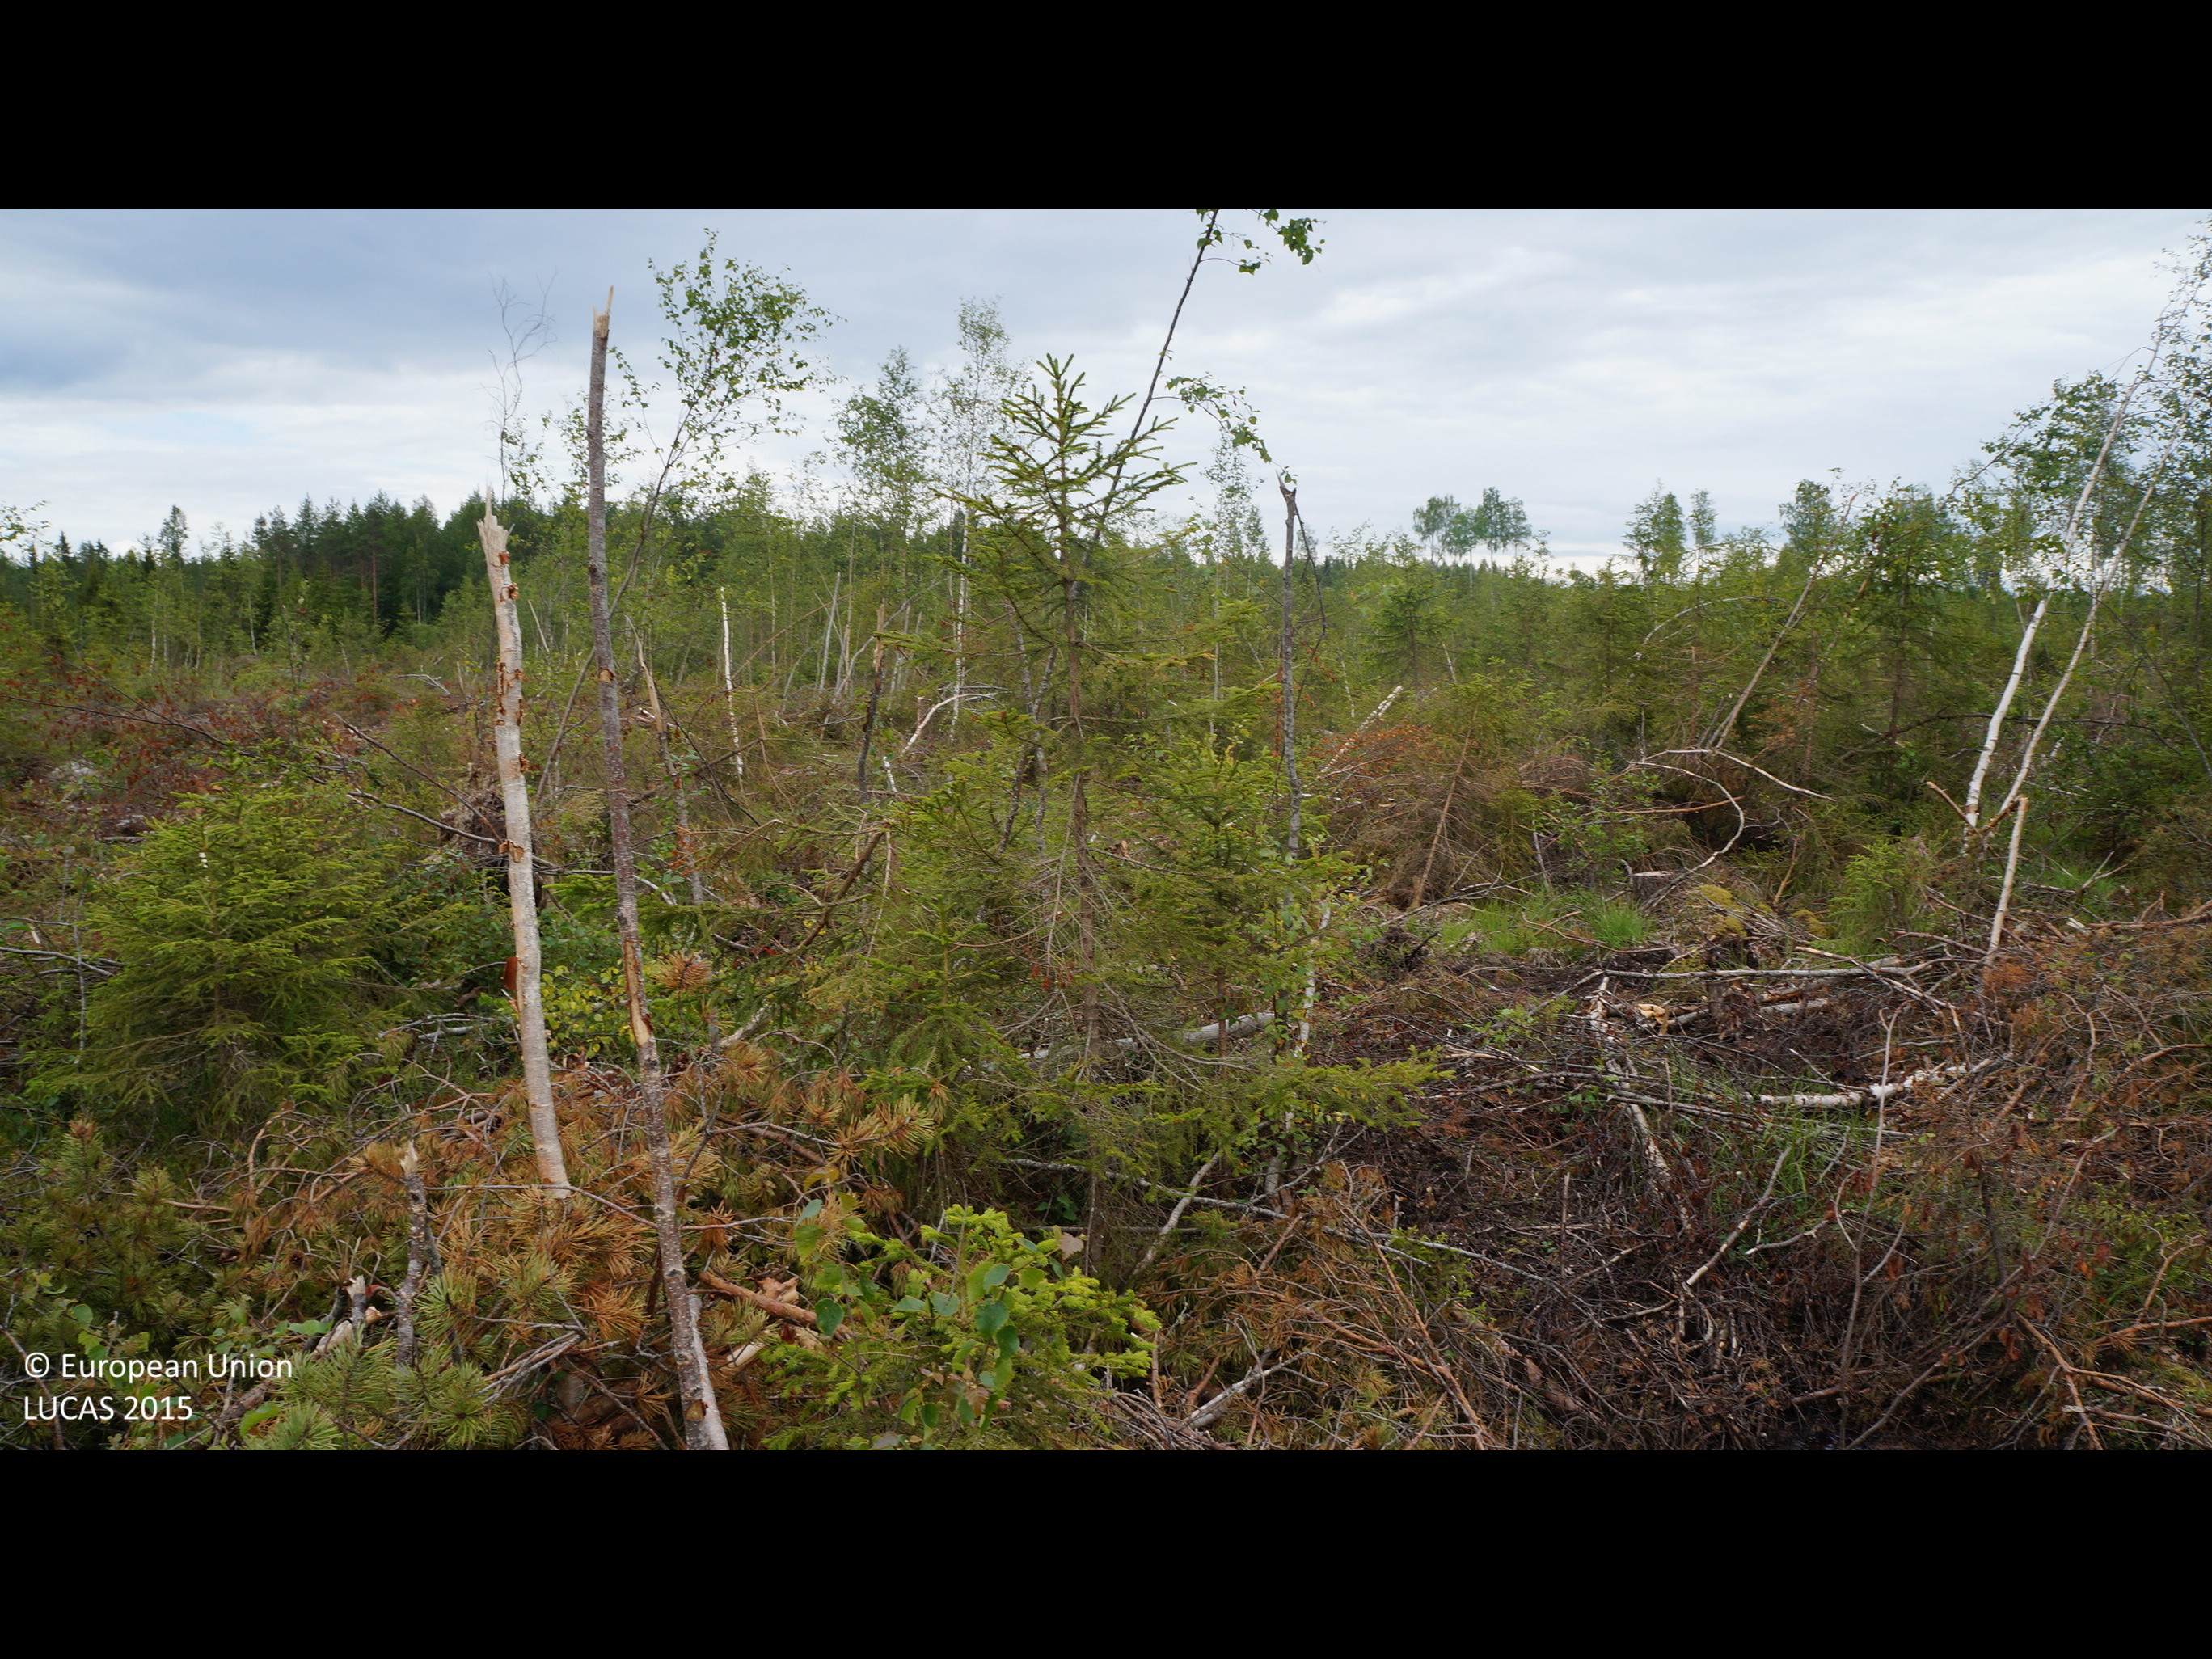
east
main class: Shrubland
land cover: Shrubland with sparse tree cover
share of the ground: > 75 %
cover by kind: shrubs 80 %, broadleaved forest trees 5 %, lichens and mosses 5 %, consolidated bare surface 5 %, unconsolidated bare surface 5 %
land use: Forestry
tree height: > 5 m
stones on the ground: 10 - 25 %
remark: Clear cut
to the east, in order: Shrubland with sparse tree cover; Ditches and canals; Shrubland with sparse tree cover; Ditches and canals; Pine dominated mixed woodland; Ditches and canals; Pine dominated mixed woodland; Ditches and canals; Spruce dominated mixed woodland; Ditches and canals; Pine dominated mixed woodland
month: July
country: FI
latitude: 64.0222
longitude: 24.5002
